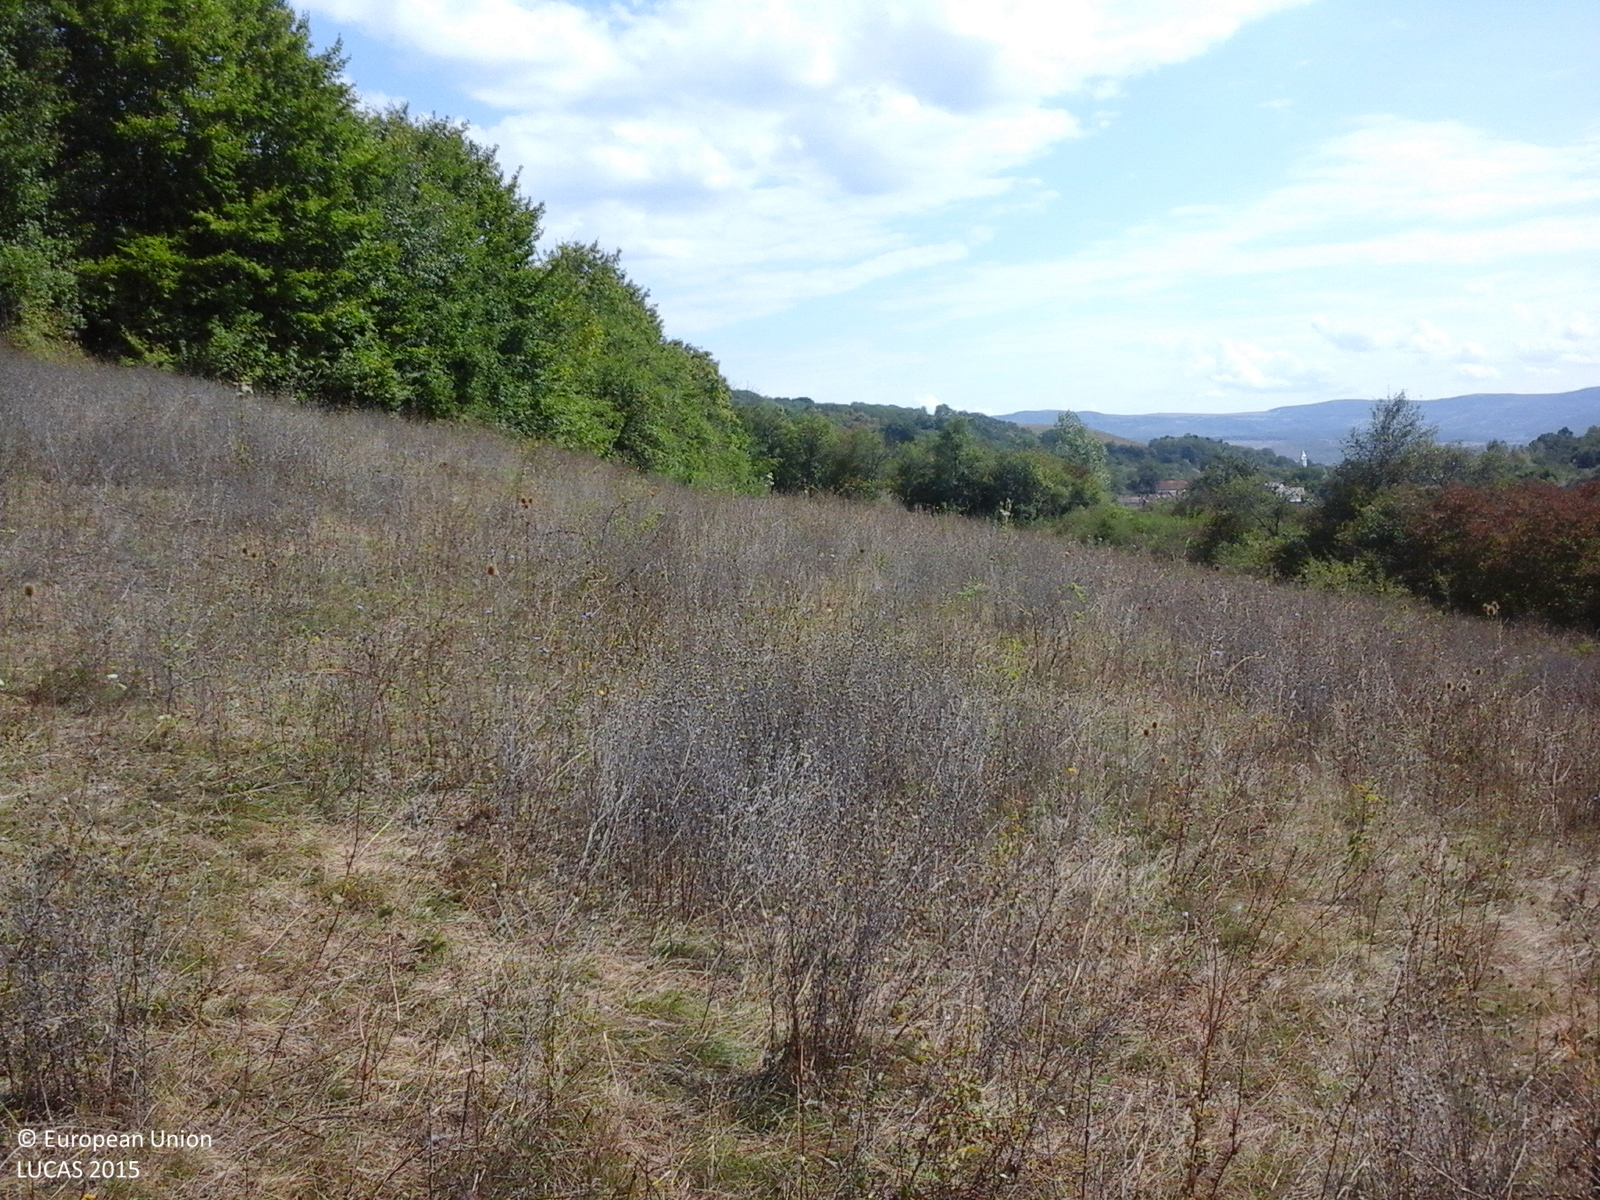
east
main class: Grassland
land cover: Grassland with sparse tree/shrub cover
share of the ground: > 75 %
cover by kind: herbaceous plants 95 %, broadleaved forest trees 5 %
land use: Agriculture (excluding fallow land and kitchen gardens)
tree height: > 5 m
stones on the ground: < 10 %
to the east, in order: Grassland with sparse tree/shrub cover; Abandoned hedges; Grassland with sparse tree/shrub cover; Broadleaved woodland; Vineyards; Shrubland without tree cover; Grassland with sparse tree/shrub cover
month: September
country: RO
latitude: 47.3655
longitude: 23.2438
